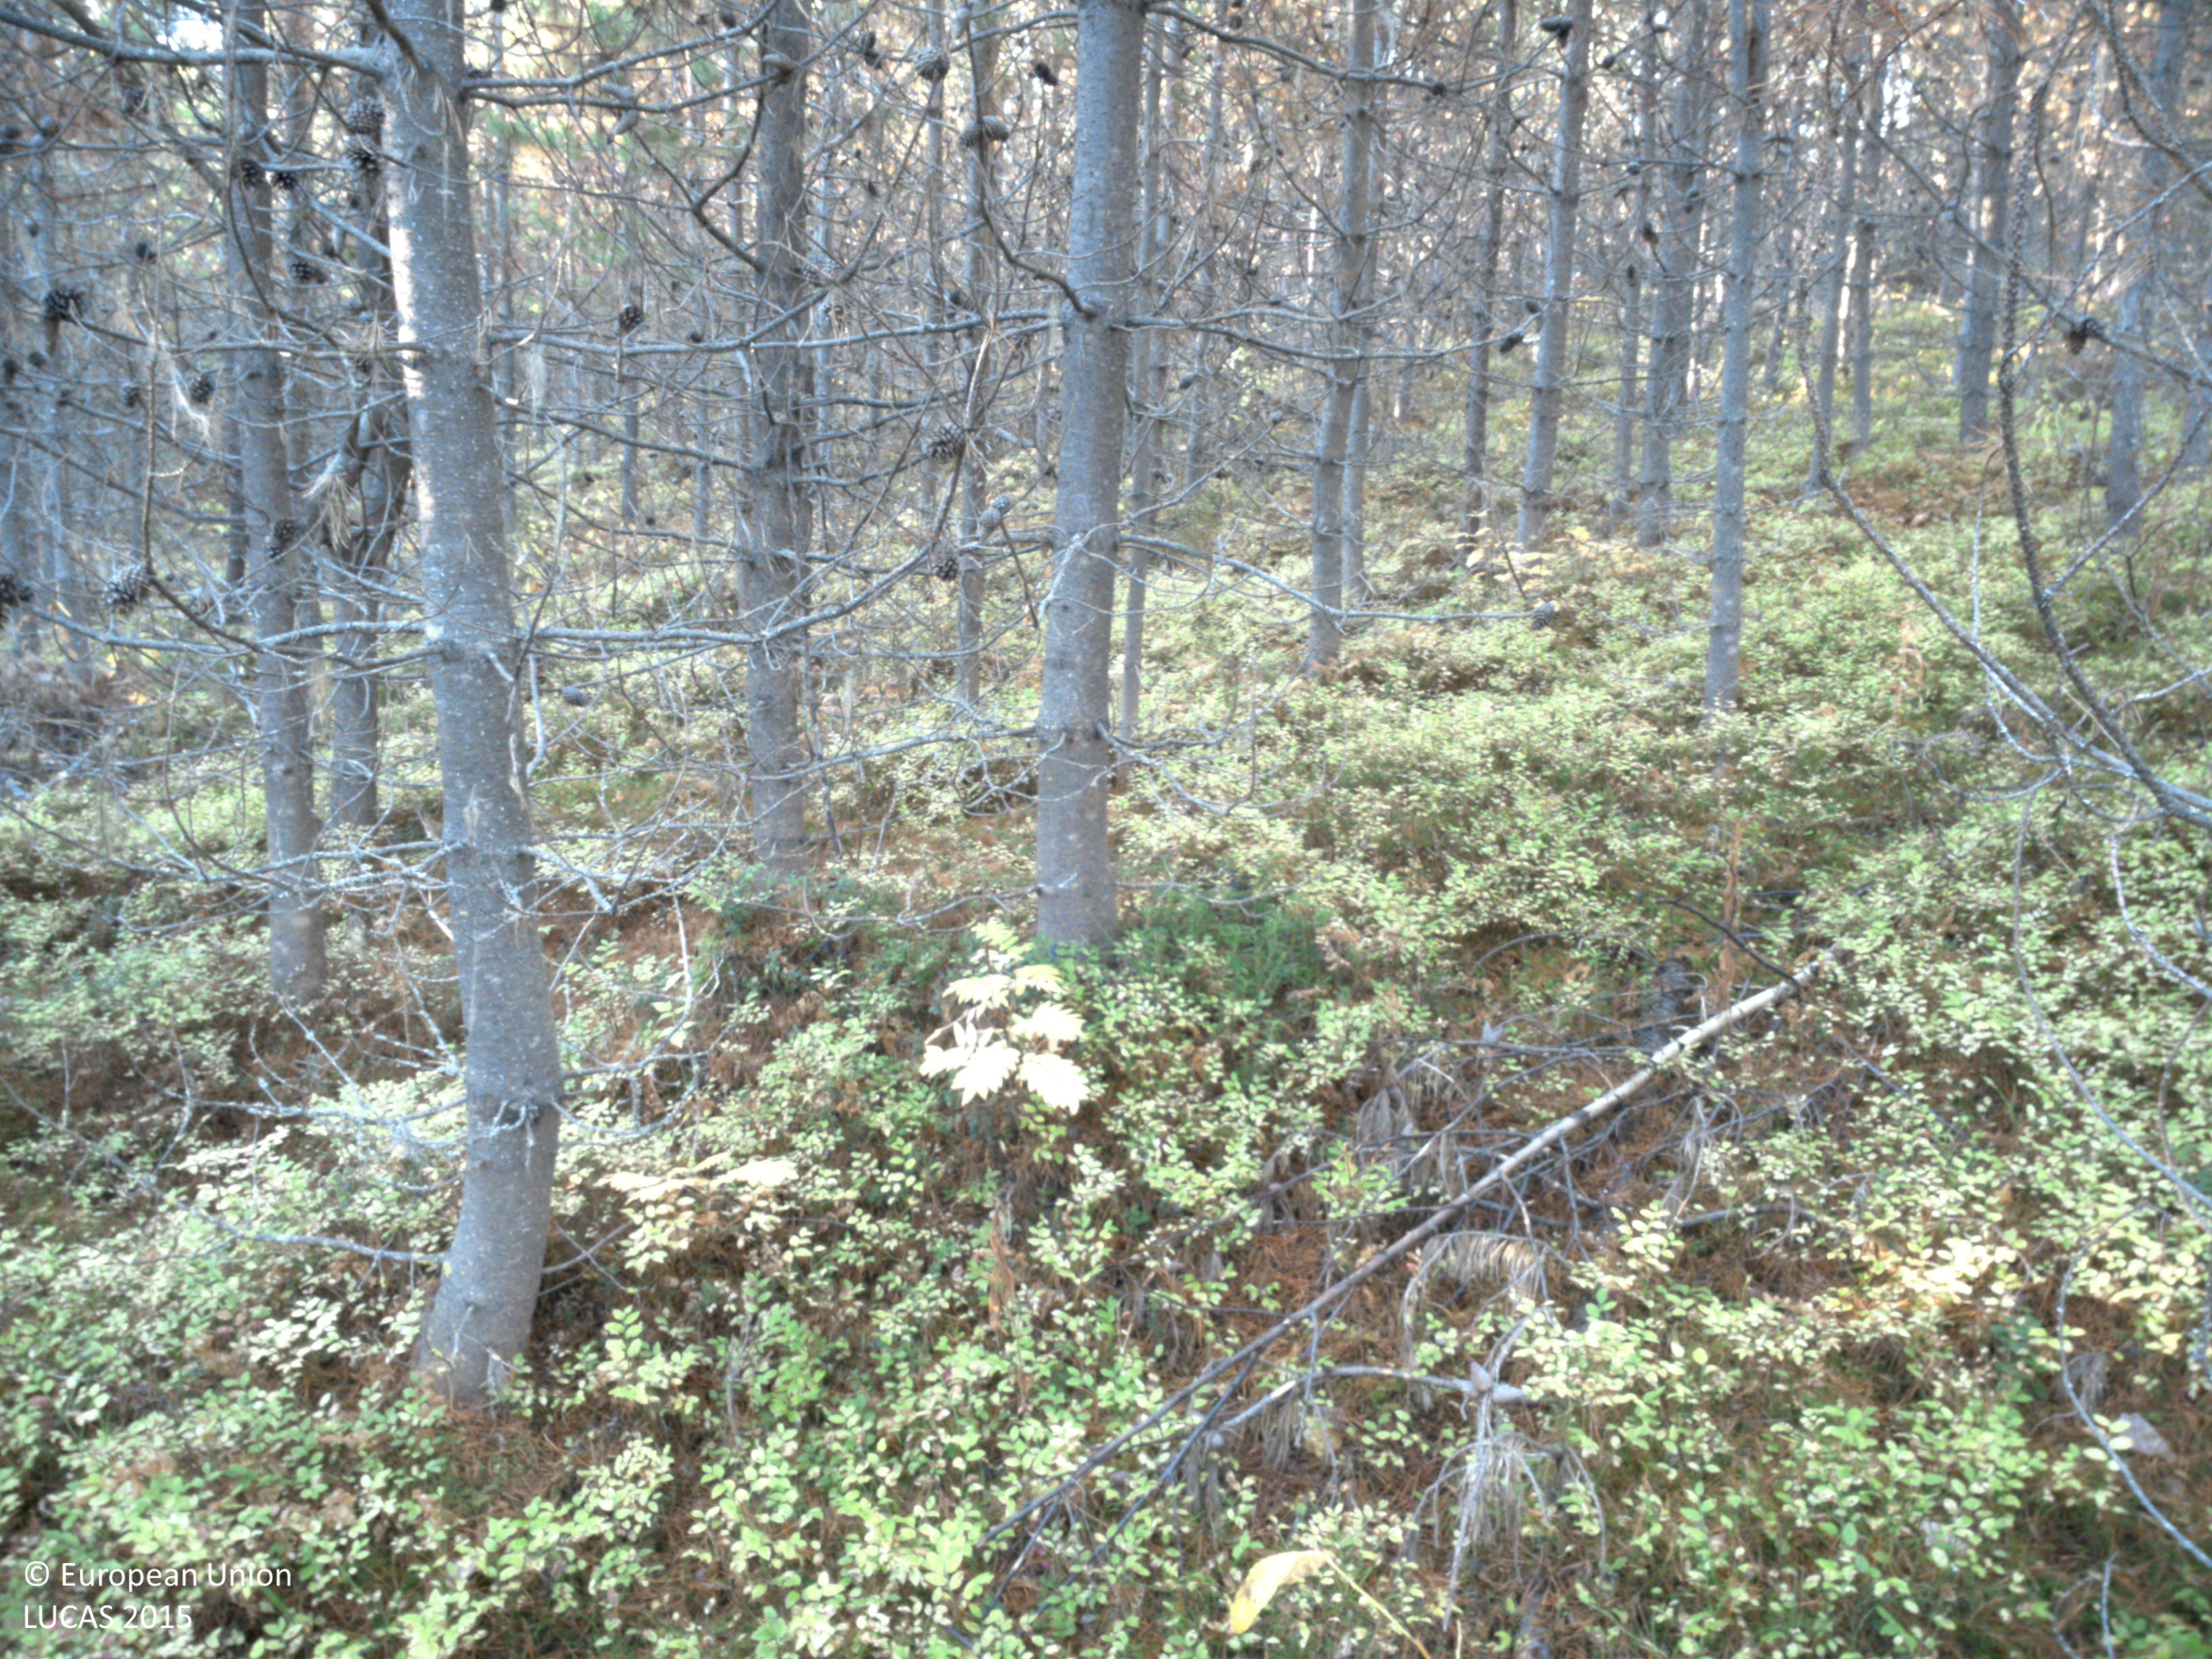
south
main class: Woodland
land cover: Pine dominated coniferous woodland
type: exotic forest
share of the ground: 50 - 75 %
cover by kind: coniferous forest trees 60 %, shrubs 25 %, lichens and mosses 10 %, broadleaved forest trees 5 %
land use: Forestry
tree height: > 5 m
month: October
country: SE
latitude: 64.8585
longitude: 17.8332
